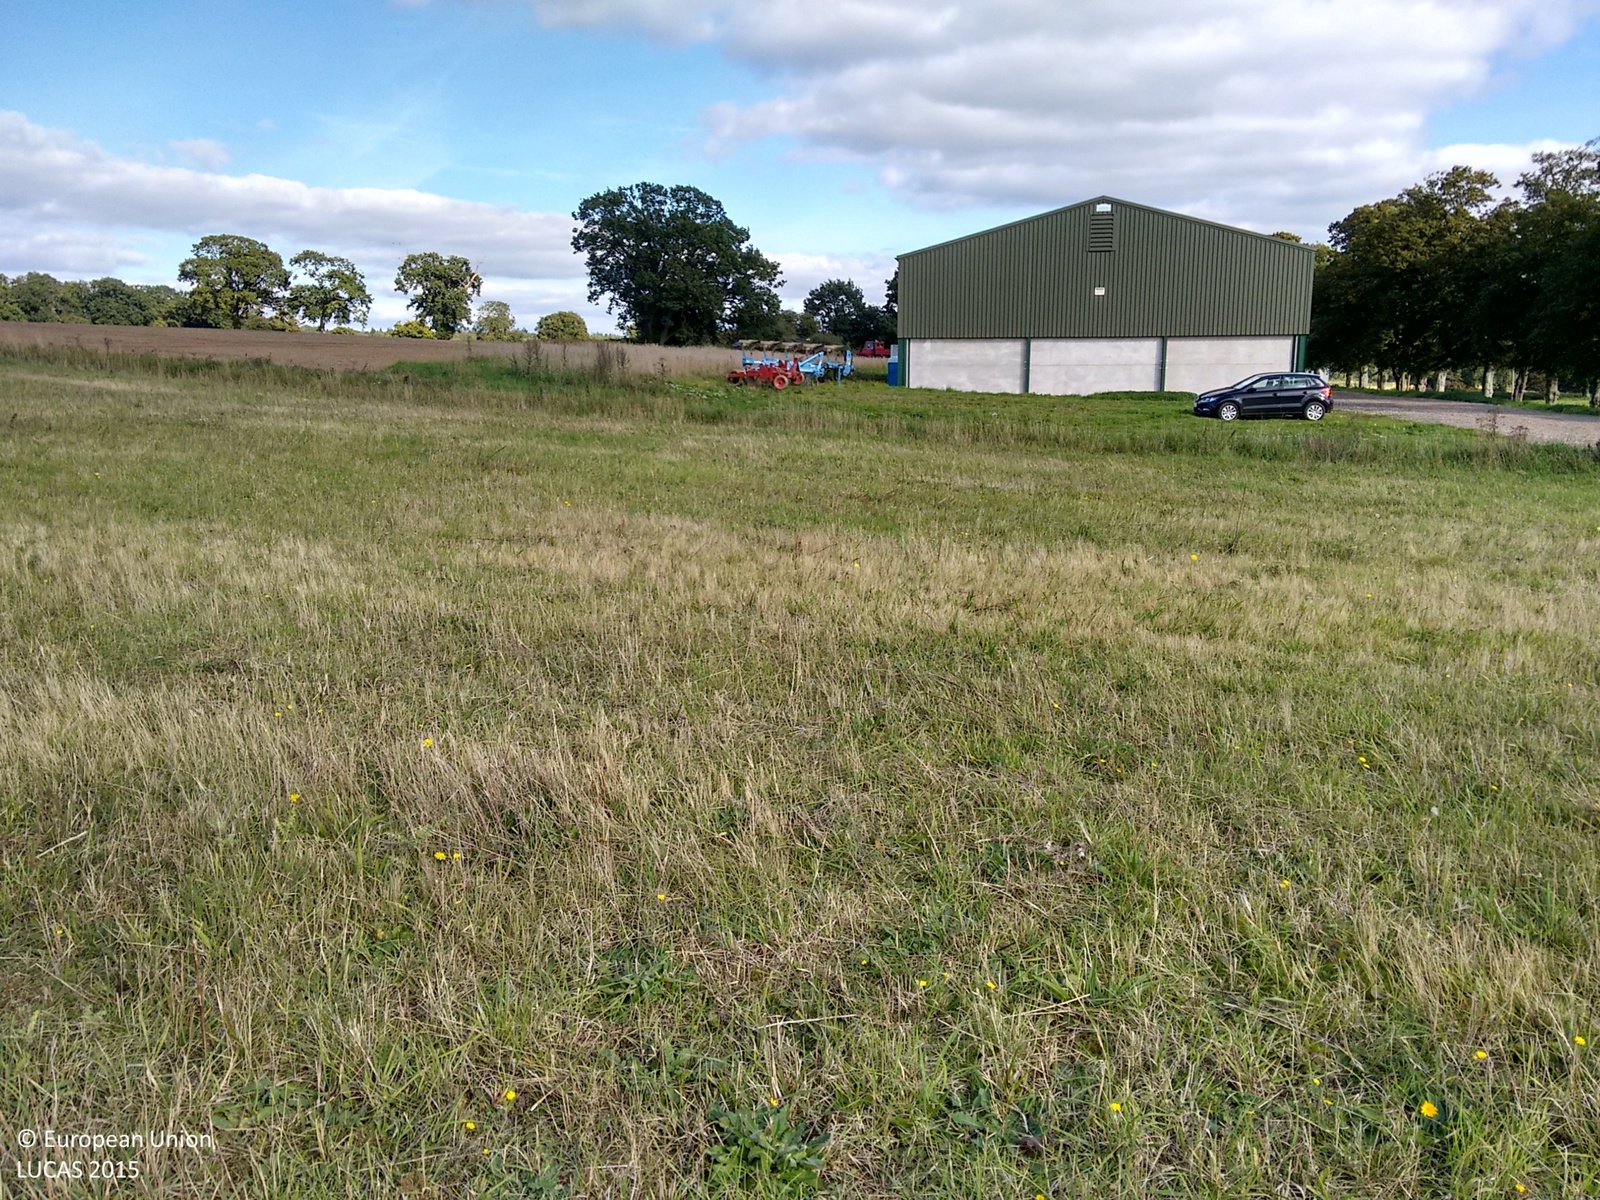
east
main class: Grassland
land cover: Grassland without tree/shrub cover
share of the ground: > 75 %
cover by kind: herbaceous plants 100 %
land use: Agriculture (excluding fallow land and kitchen gardens)
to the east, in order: Grassland without tree/shrub cover; Tracks; Grassland without tree/shrub cover; Artificial constructions in urban areas; Grassland without tree/shrub cover; Tracks; Electric lines; Grassland without tree/shrub cover; Artificial constructions in urban areas
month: September
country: GB
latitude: 52.3900
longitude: 0.9099
